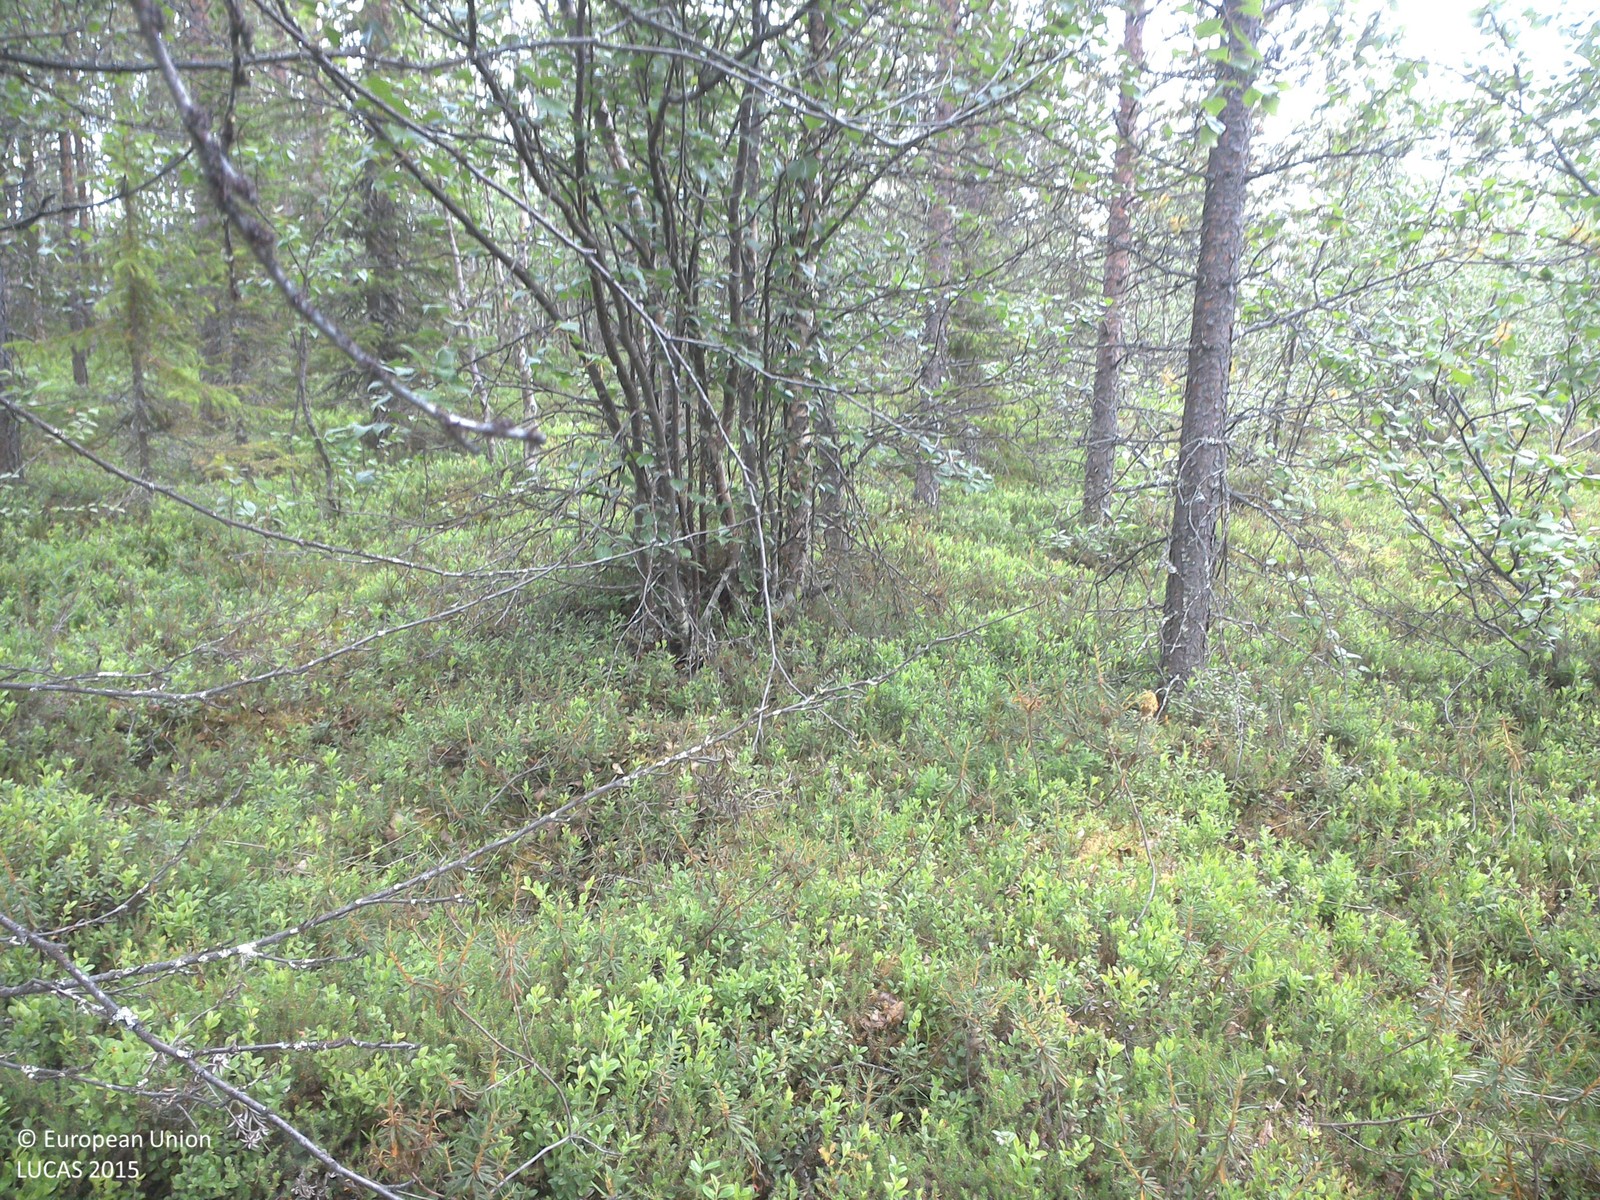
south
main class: Woodland
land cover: Pine dominated mixed woodland
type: boreal forest
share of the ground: 25 - 50 %
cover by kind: shrubs 60 %, coniferous forest trees 20 %, broadleaved forest trees 15 %, lichens and mosses 5 %
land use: Forestry
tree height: > 5 m
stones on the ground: < 10 %
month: July
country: SE
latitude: 67.8061
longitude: 22.3589
